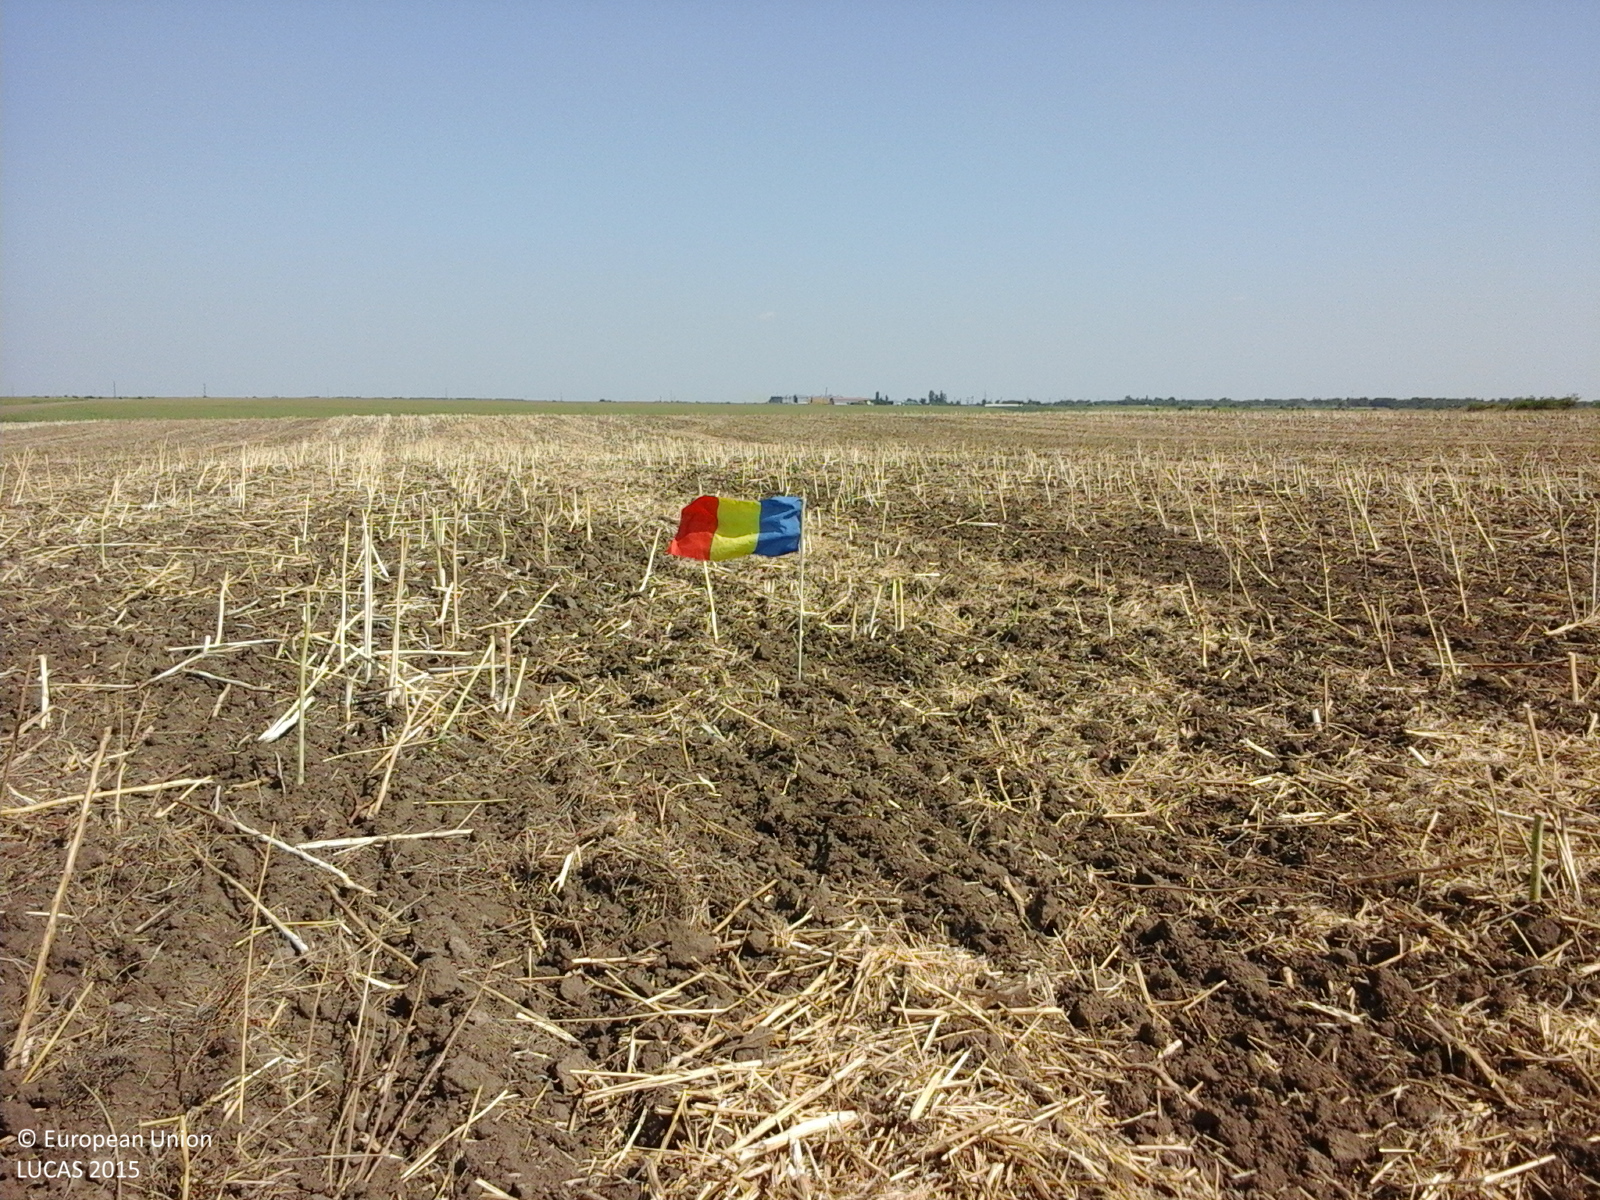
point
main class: Cropland
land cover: Rape and turnip rape
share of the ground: 10 - 25 %
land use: Agriculture (excluding fallow land and kitchen gardens)
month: July
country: RO
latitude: 44.3047
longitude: 27.0635
